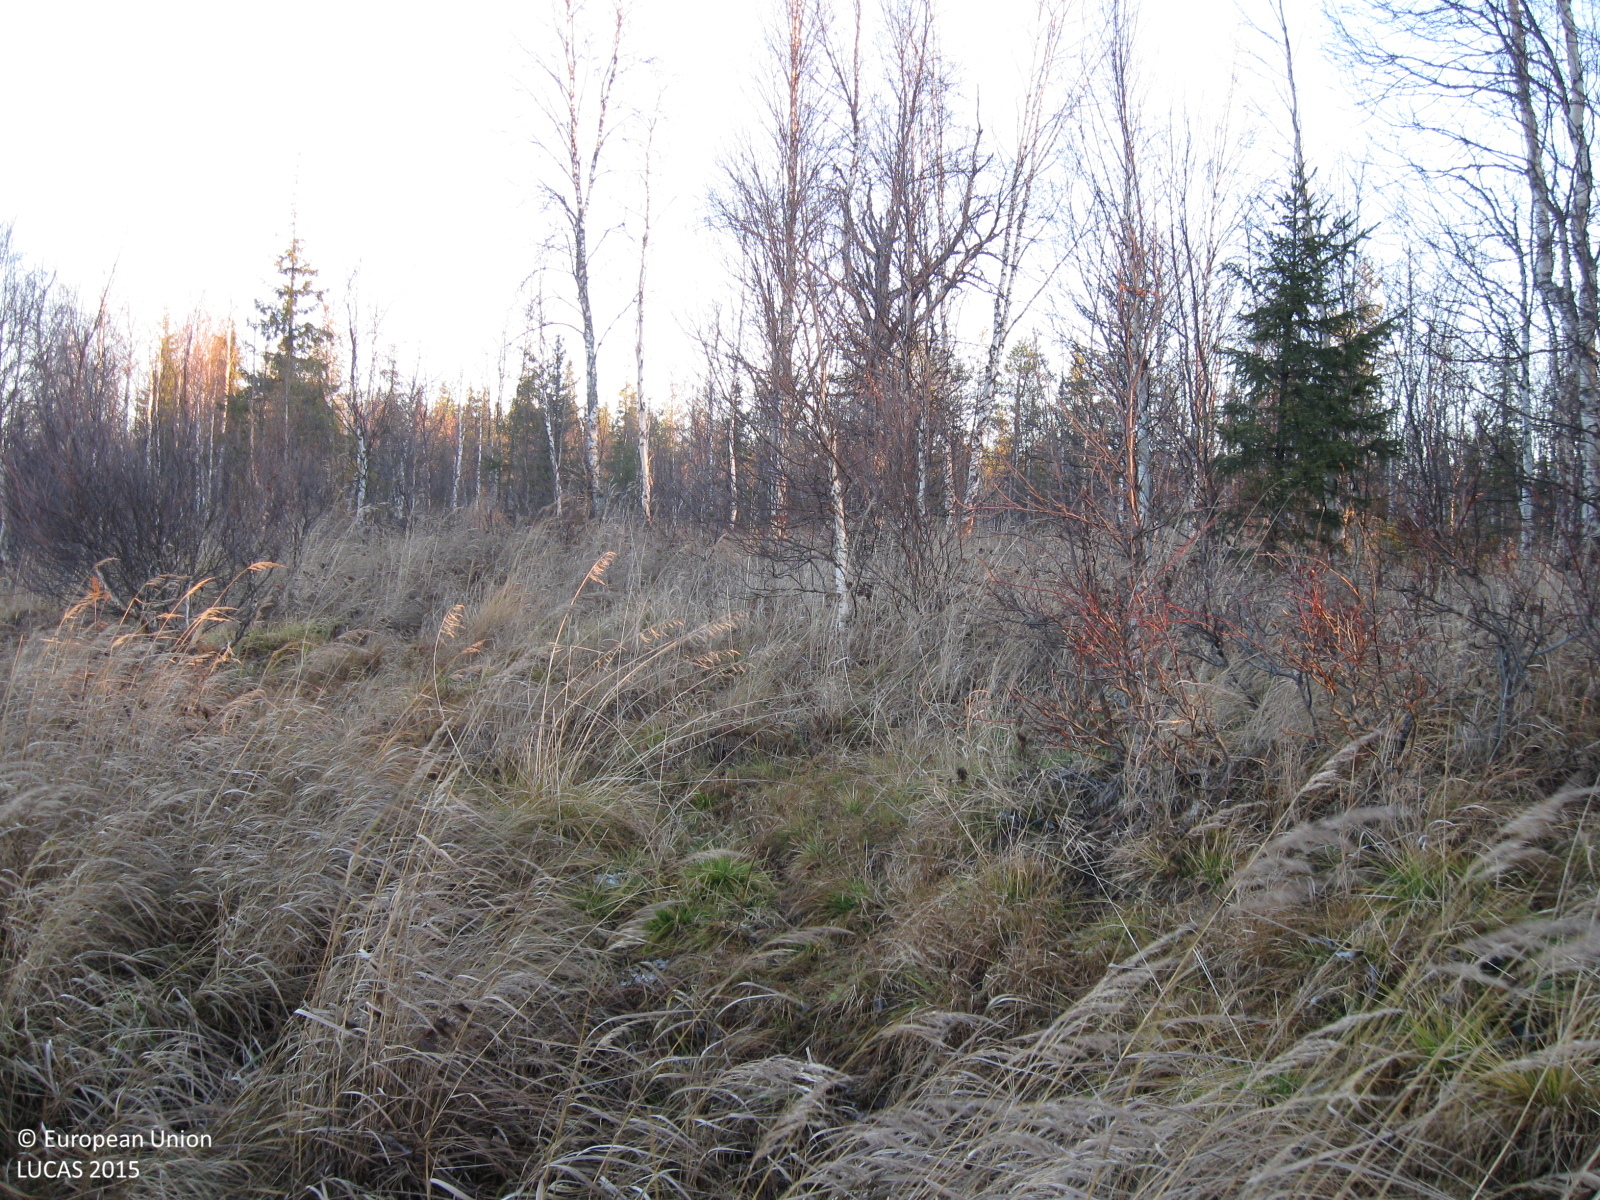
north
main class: Grassland
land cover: Grassland with sparse tree/shrub cover
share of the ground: > 75 %
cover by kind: herbaceous plants 90 %, broadleaved forest trees 5 %, shrubs 5 %
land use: Semi-natural and natural areas not in use
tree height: < 5 m
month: November
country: SE
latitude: 66.2136
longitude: 20.6476
